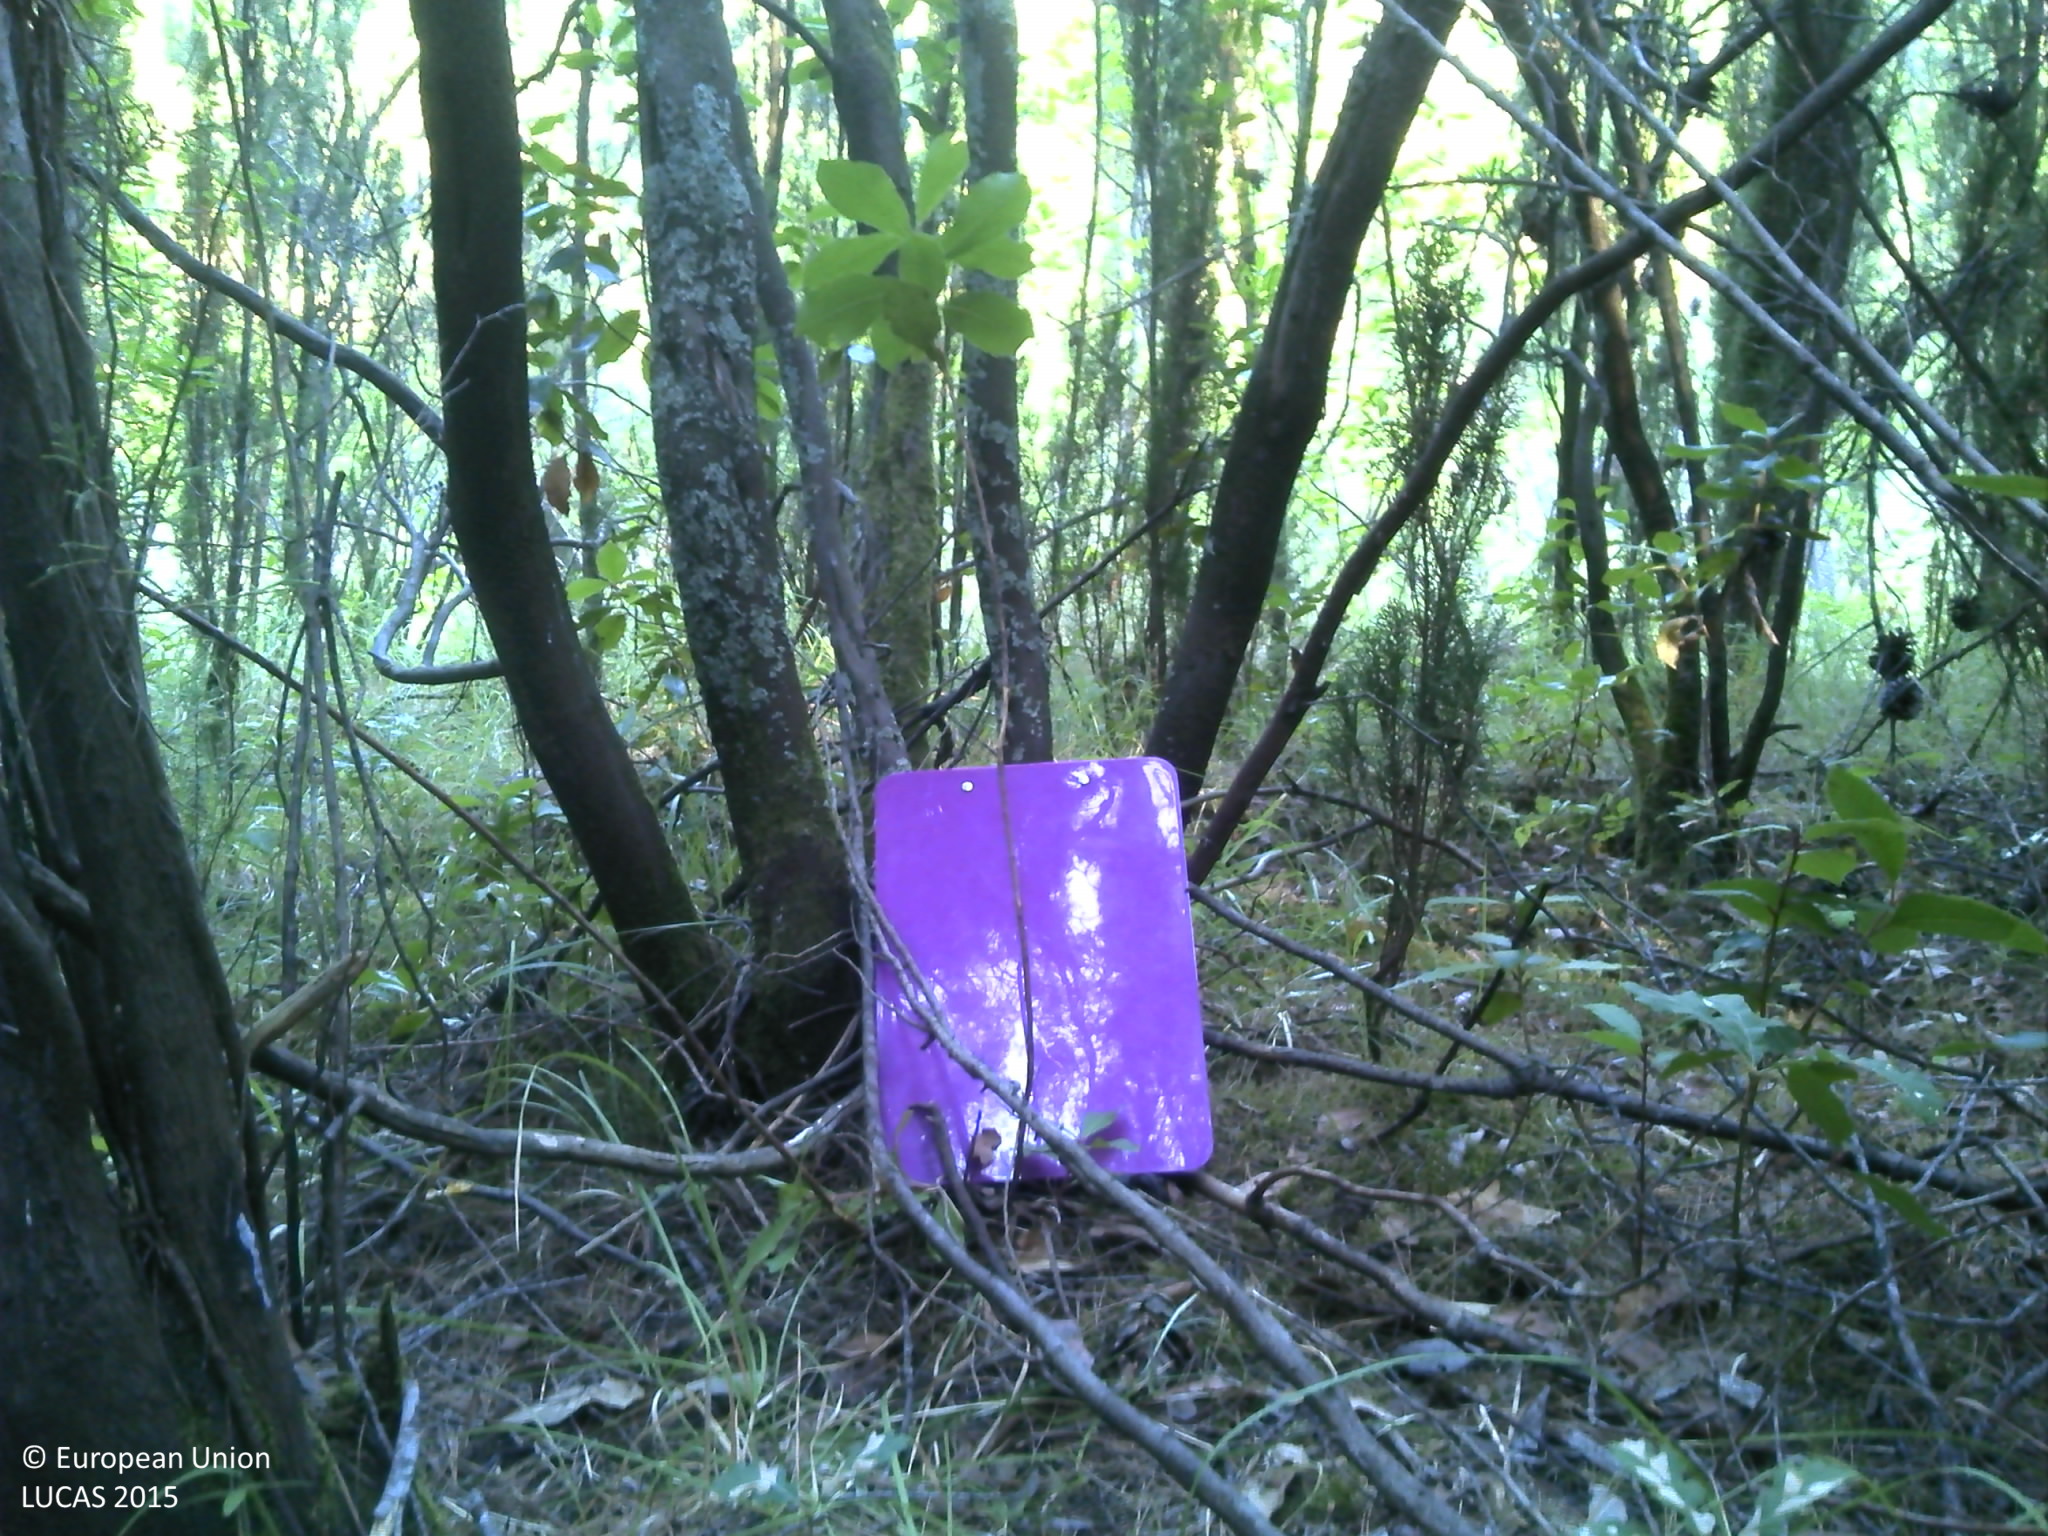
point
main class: Woodland
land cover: Other coniferous woodland
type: coniferous forest of the mediterranean region
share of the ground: > 75 %
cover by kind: coniferous forest trees 80 %, herbaceous plants 10 %, shrubs 5 %, consolidated bare surface 5 %
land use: Semi-natural and natural areas not in use
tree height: > 5 m
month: July
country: HR
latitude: 42.5222
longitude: 18.4019
